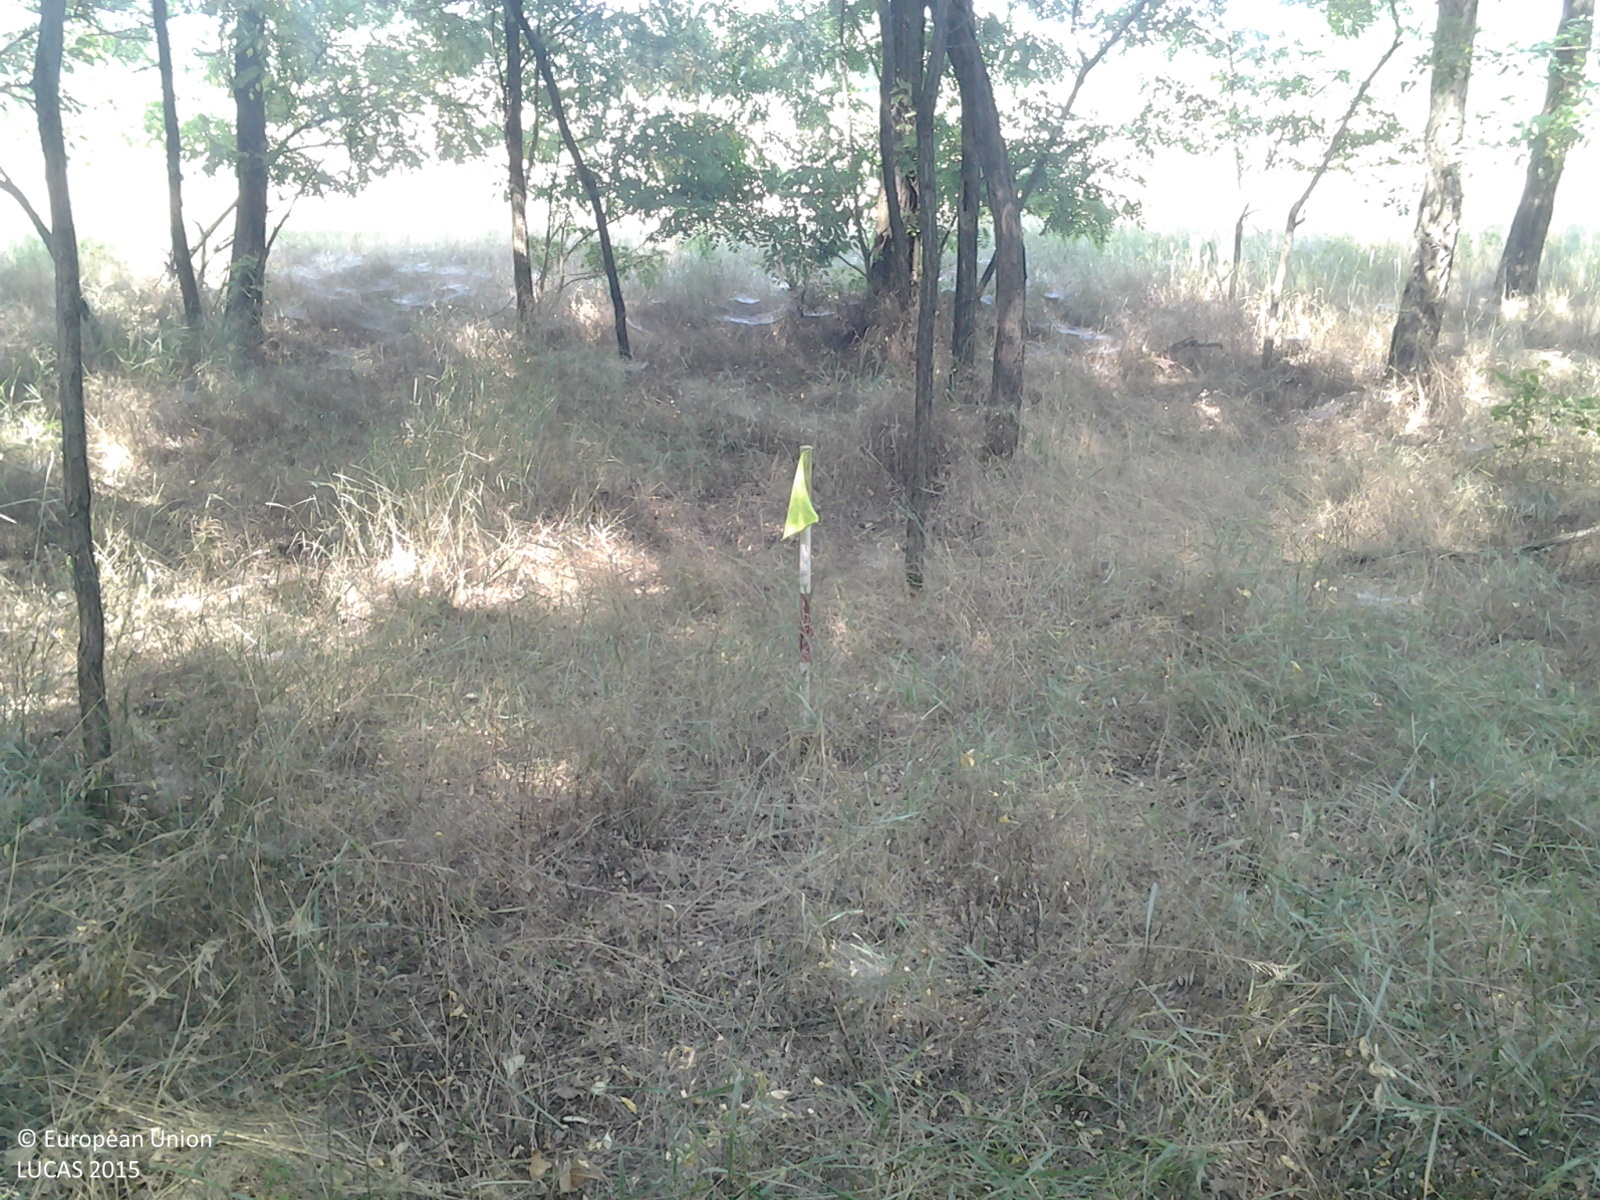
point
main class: Woodland
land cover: Broadleaved woodland
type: mesophytic deciduous forest
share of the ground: 50 - 75 %
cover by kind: broadleaved forest trees 70 %, herbaceous plants 30 %
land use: Forestry
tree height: > 5 m
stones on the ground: < 10 %
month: July
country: HU
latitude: 47.4346
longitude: 19.8758
